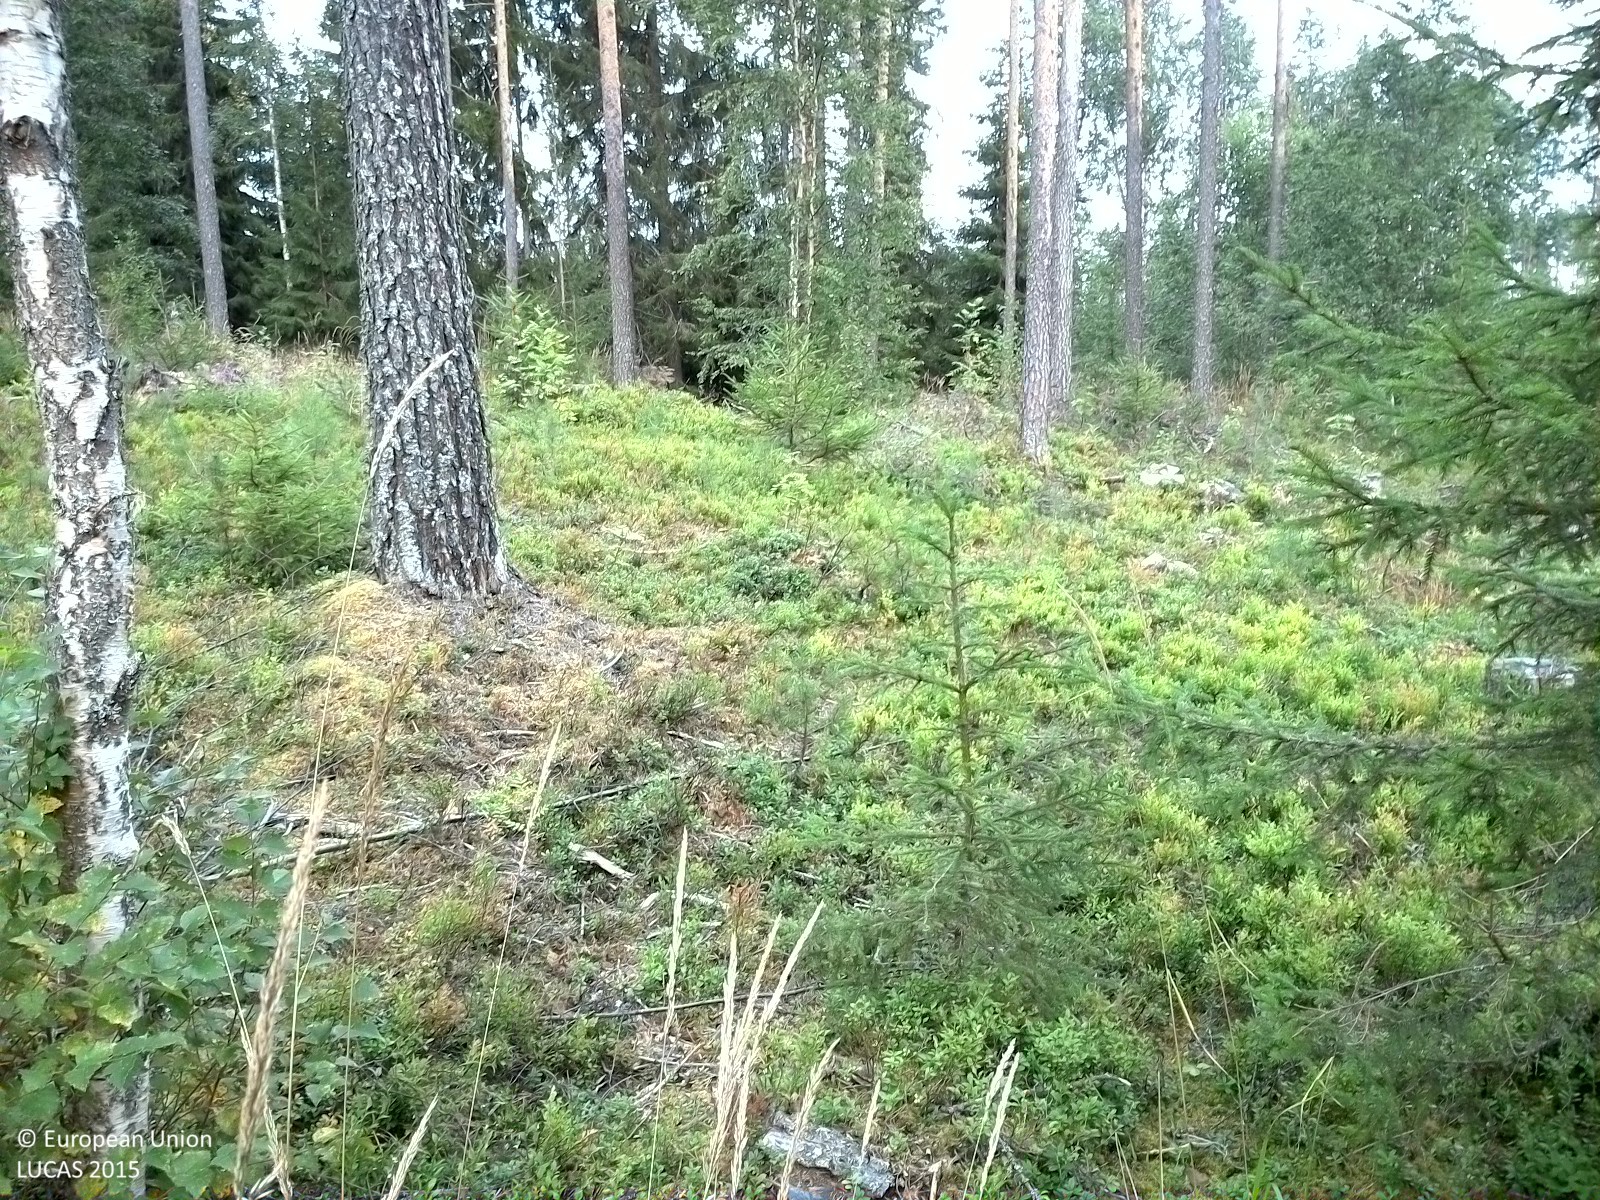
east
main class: Woodland
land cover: Pine dominated coniferous woodland
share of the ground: 50 - 75 %
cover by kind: coniferous forest trees 45 %, shrubs 20 %, herbaceous plants 20 %, broadleaved forest trees 10 %, lichens and mosses 5 %
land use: Forestry
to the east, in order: Pine dominated coniferous woodland; Other coniferous woodland; Broadleaved woodland; Other bare soil; Shrubland with sparse tree cover; Other mixed woodland
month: August
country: SE
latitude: 62.4991
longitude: 16.2881
